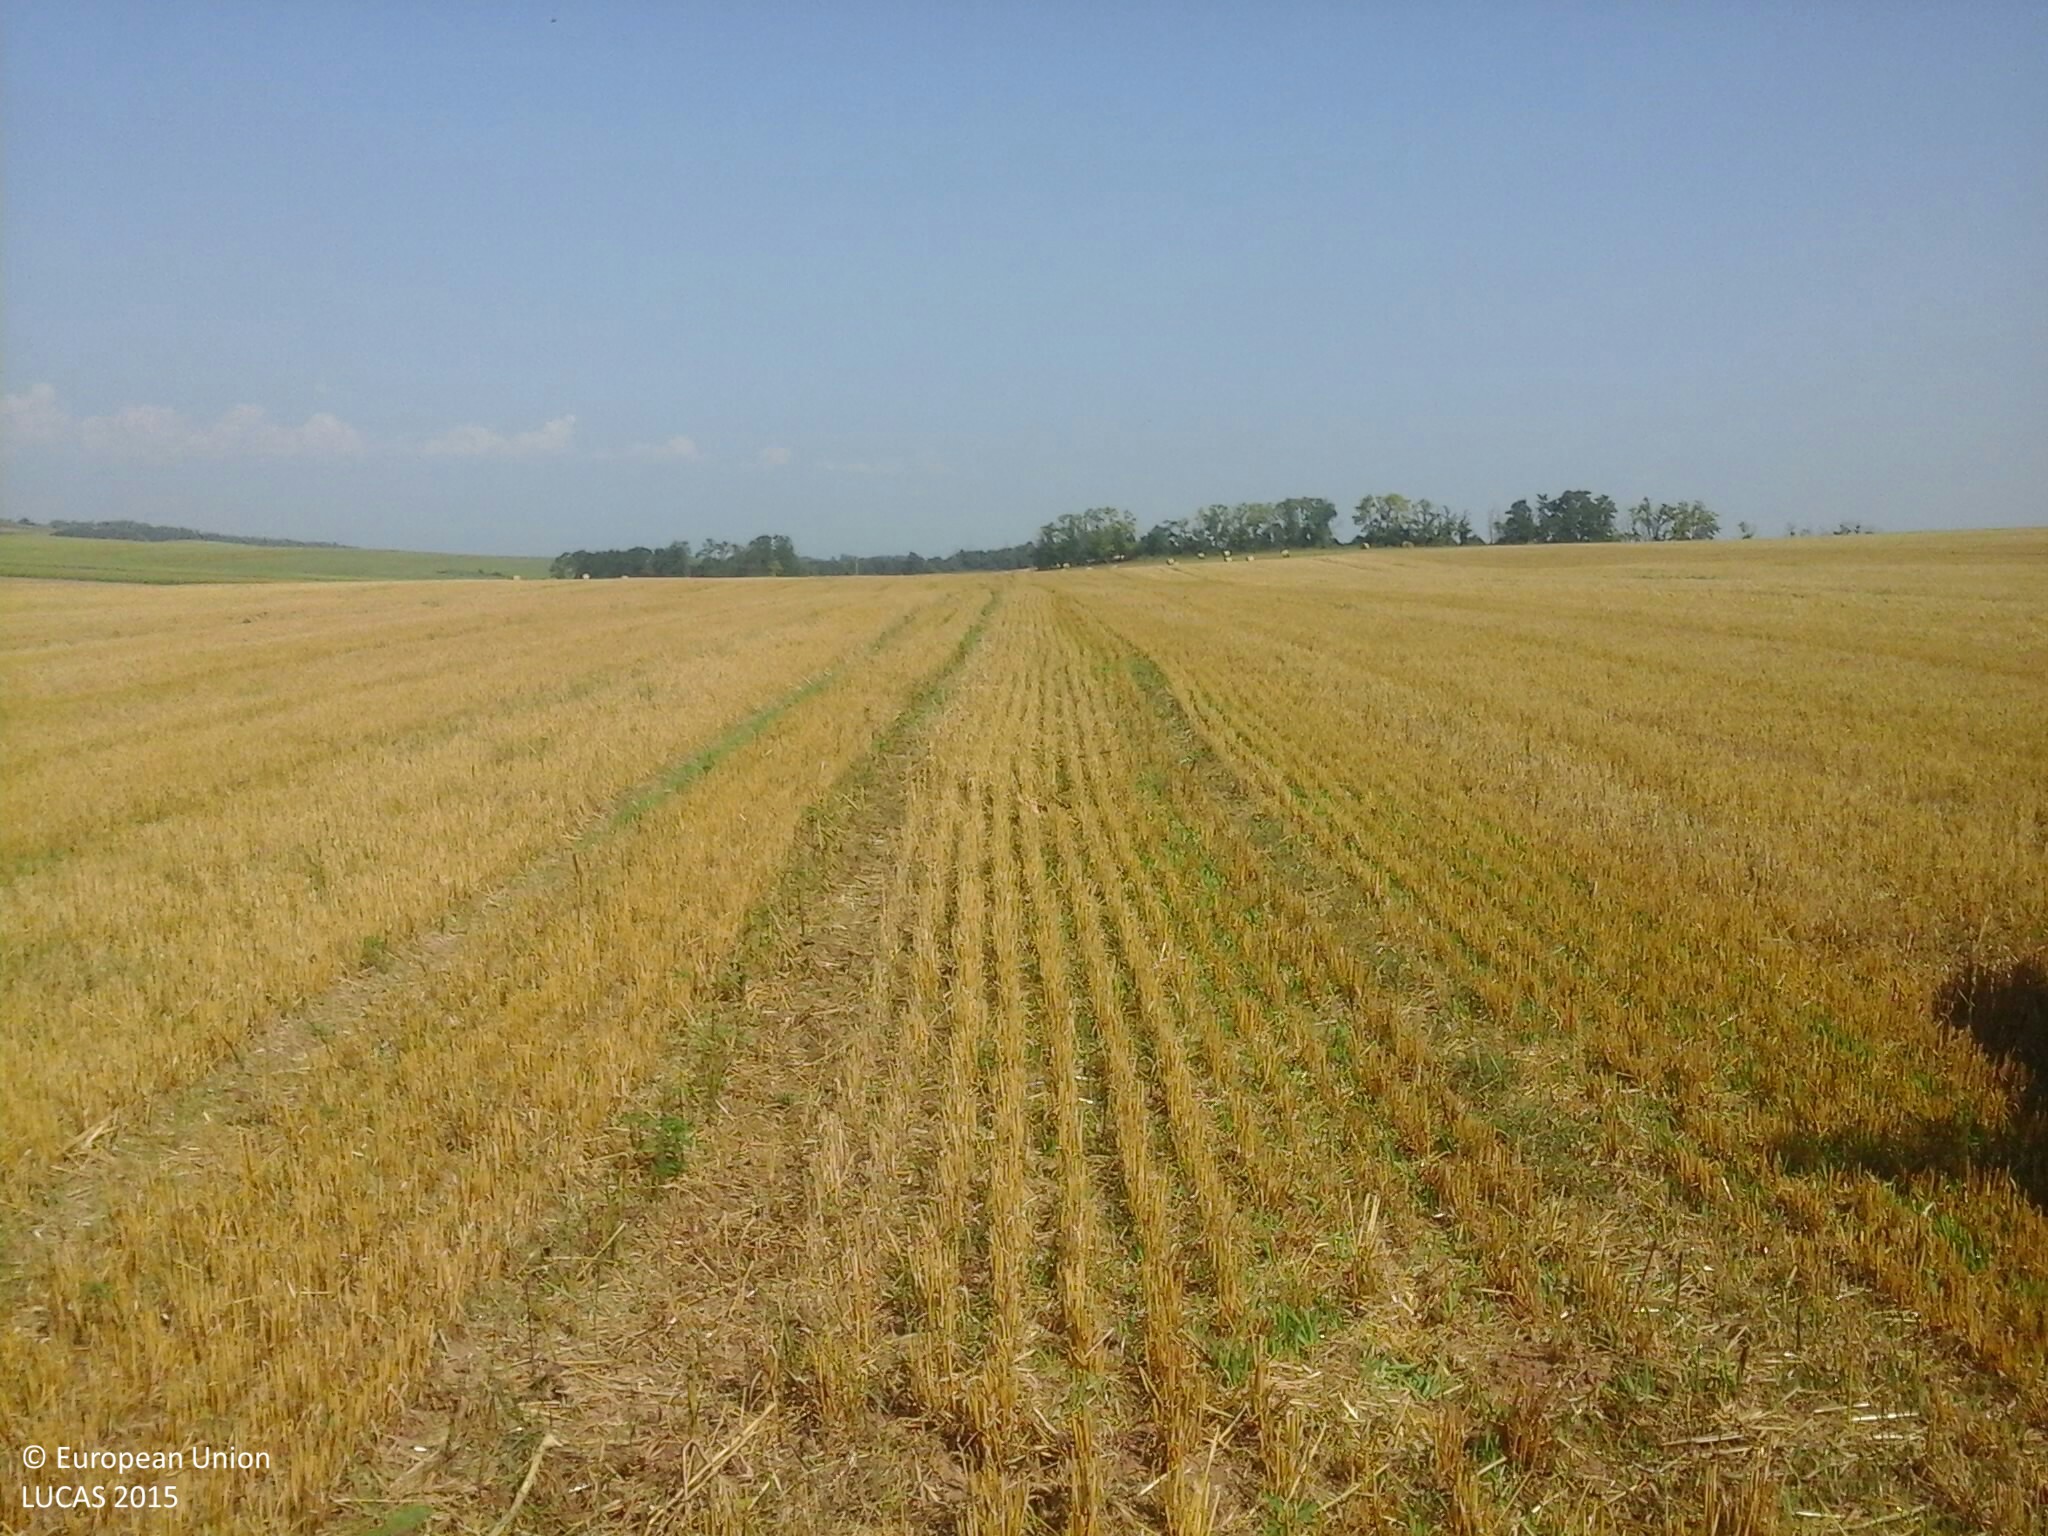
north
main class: Cropland
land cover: Barley
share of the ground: 10 - 25 %
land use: Agriculture (excluding fallow land and kitchen gardens)
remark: Harvested field
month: August
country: HU
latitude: 46.8279
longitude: 18.0184
